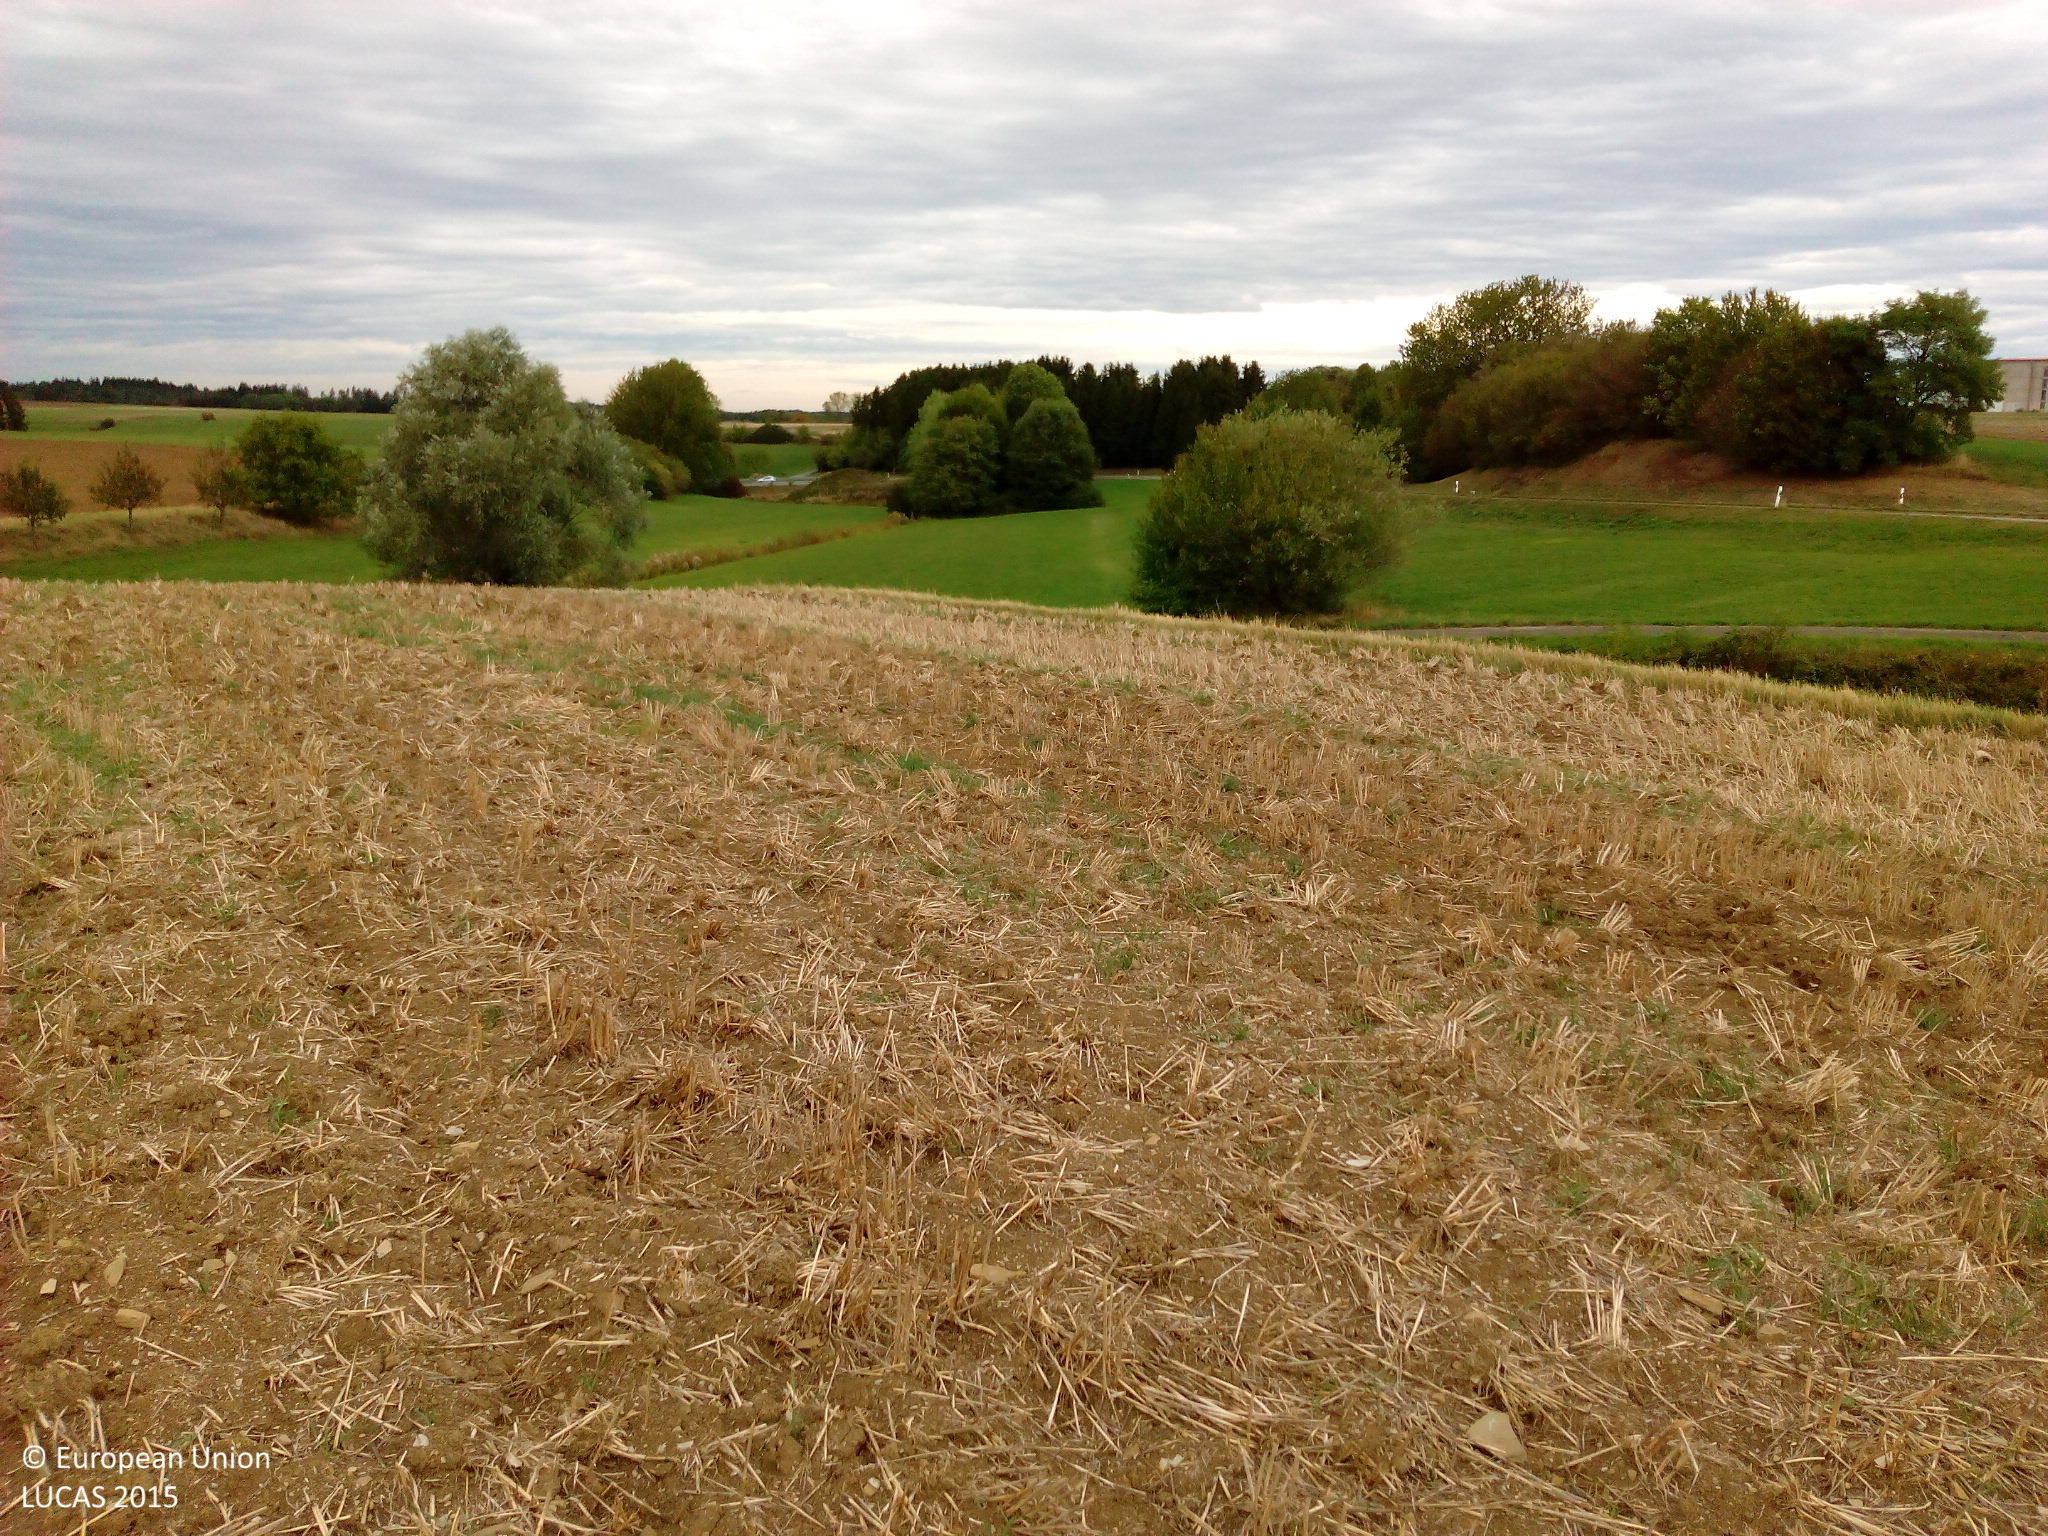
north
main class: Cropland
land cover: Common wheat
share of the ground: < 10 %
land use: Agriculture (excluding fallow land and kitchen gardens)
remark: Harvested field
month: September
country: DE
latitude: 48.2164
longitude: 8.7491
